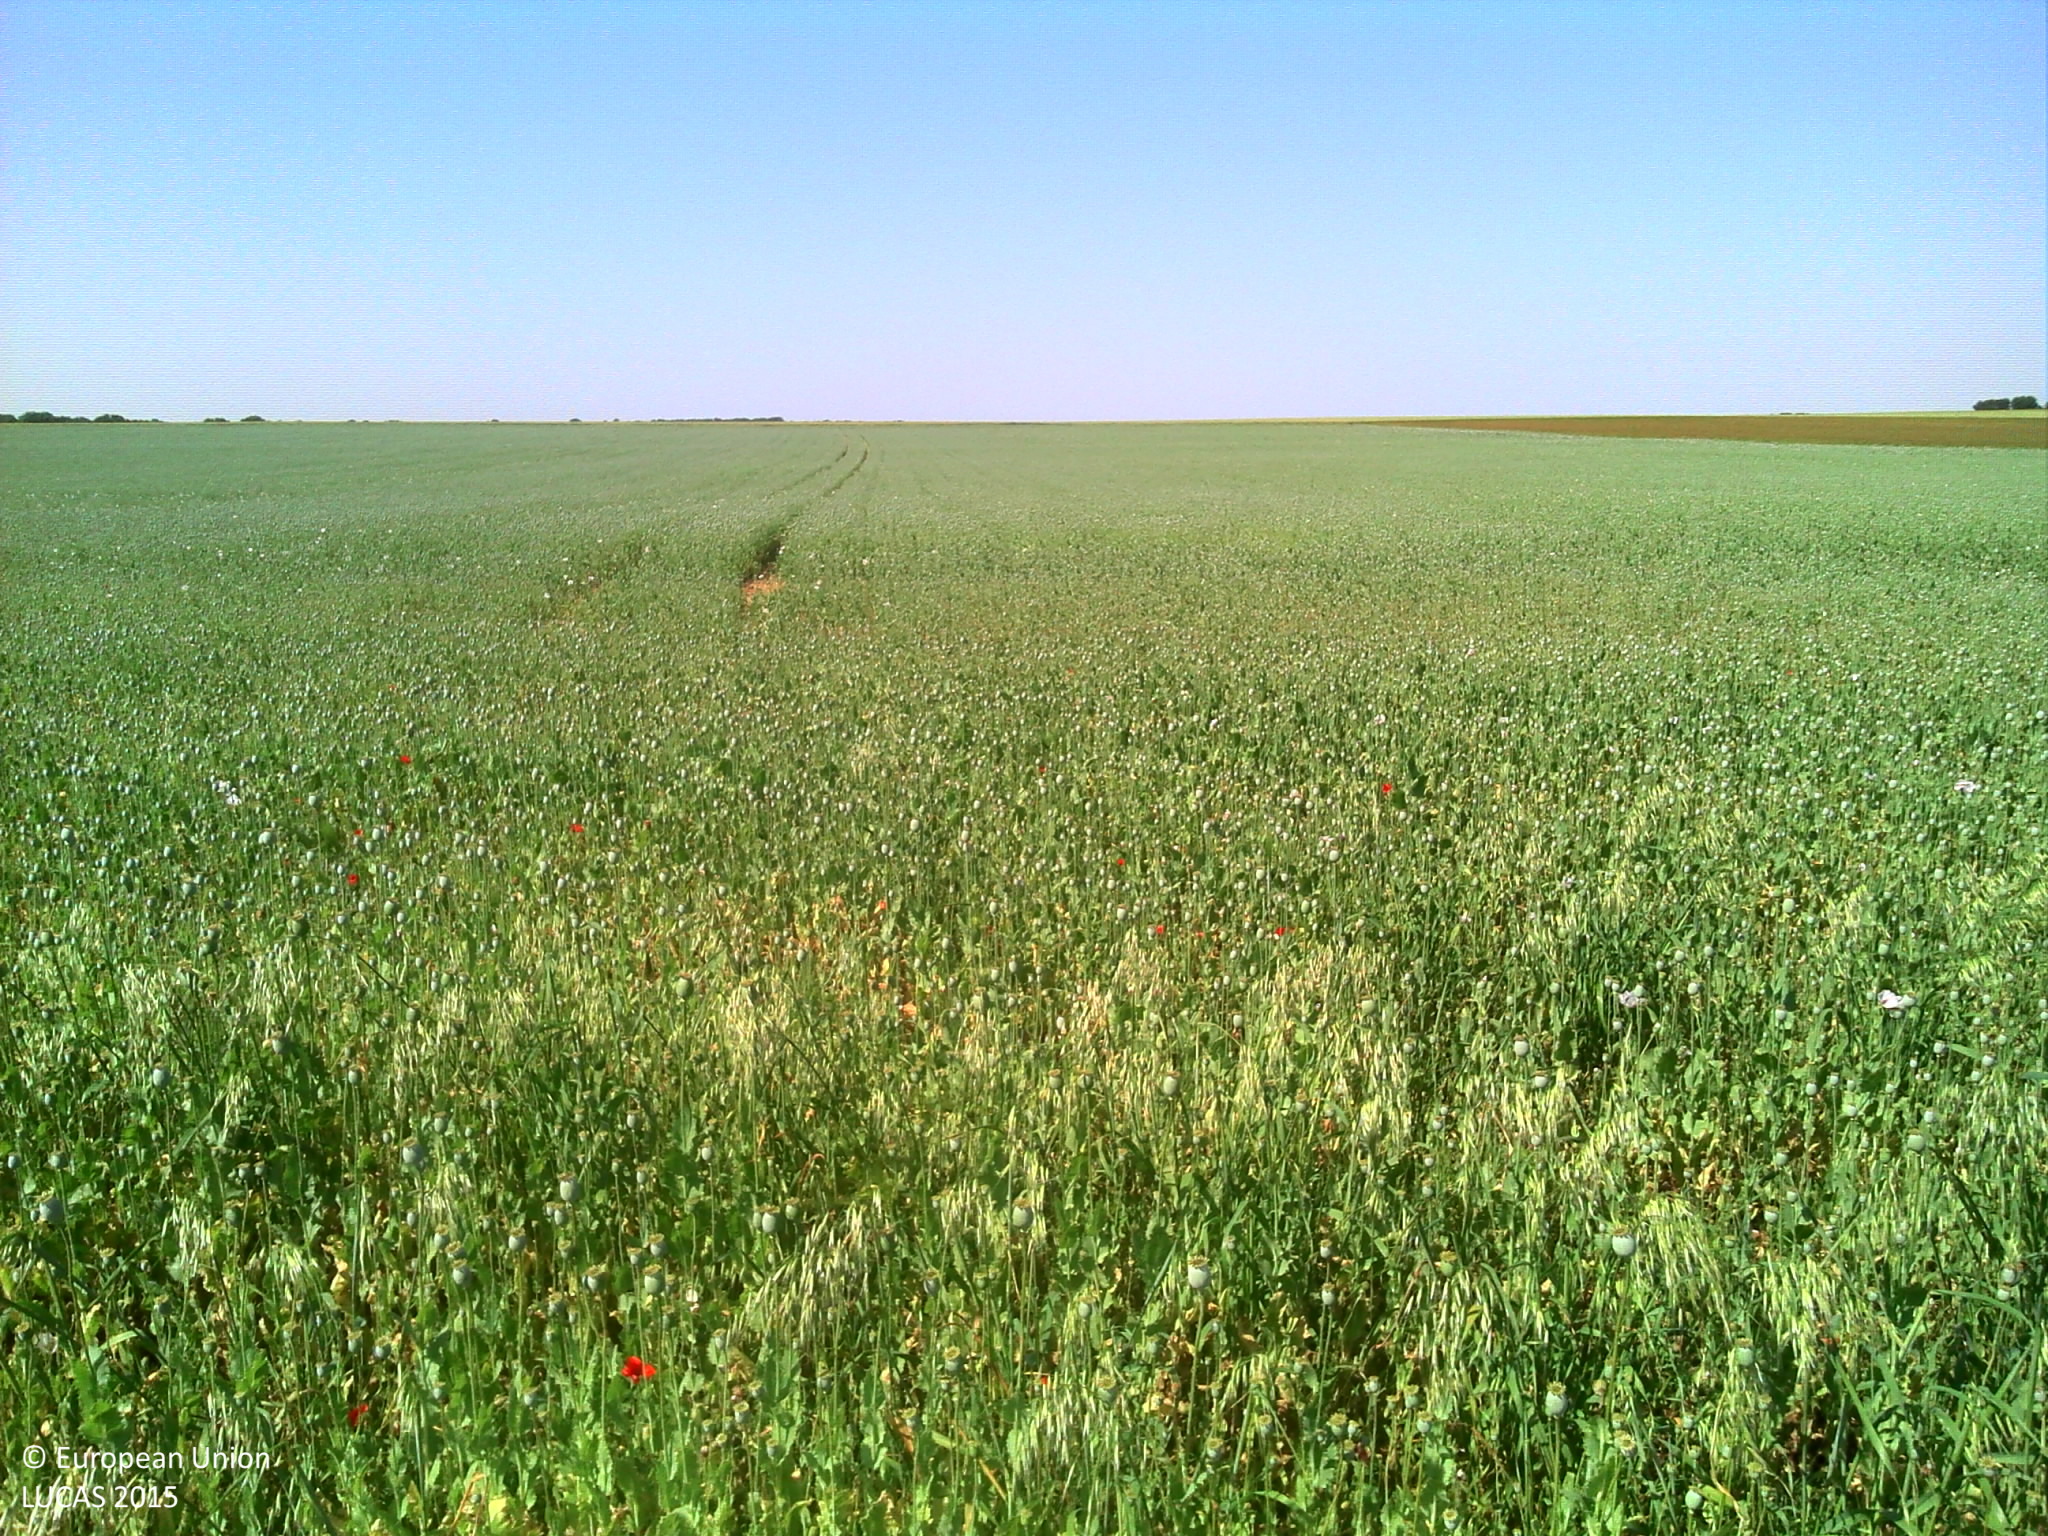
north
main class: Cropland
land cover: Mixed cereals for fodder
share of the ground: > 75 %
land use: Agriculture (excluding fallow land and kitchen gardens)
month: June
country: FR
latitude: 46.0872
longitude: -1.0360
